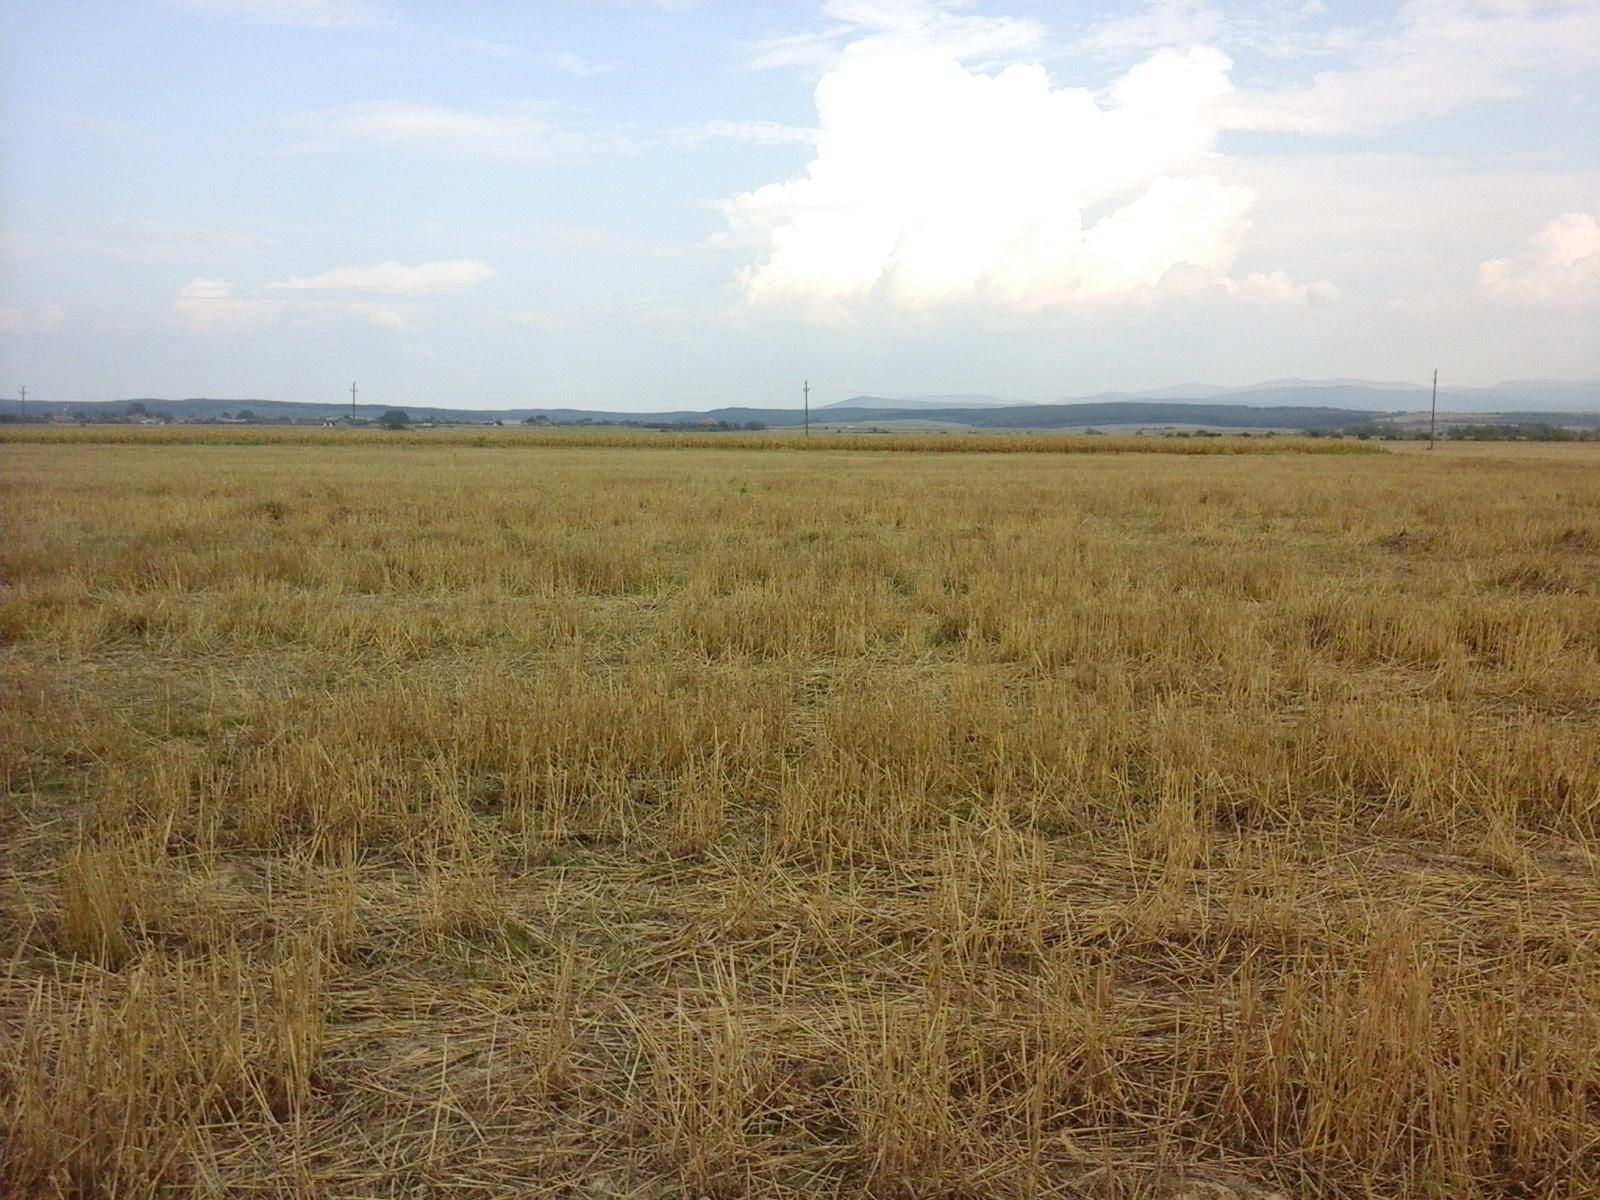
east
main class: Cropland
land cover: Common wheat
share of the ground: 25 - 50 %
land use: Agriculture (excluding fallow land and kitchen gardens)
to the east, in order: Common wheat; Maize; Common wheat; Electric lines; Common wheat
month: August
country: RO
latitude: 46.6257
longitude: 21.9422
